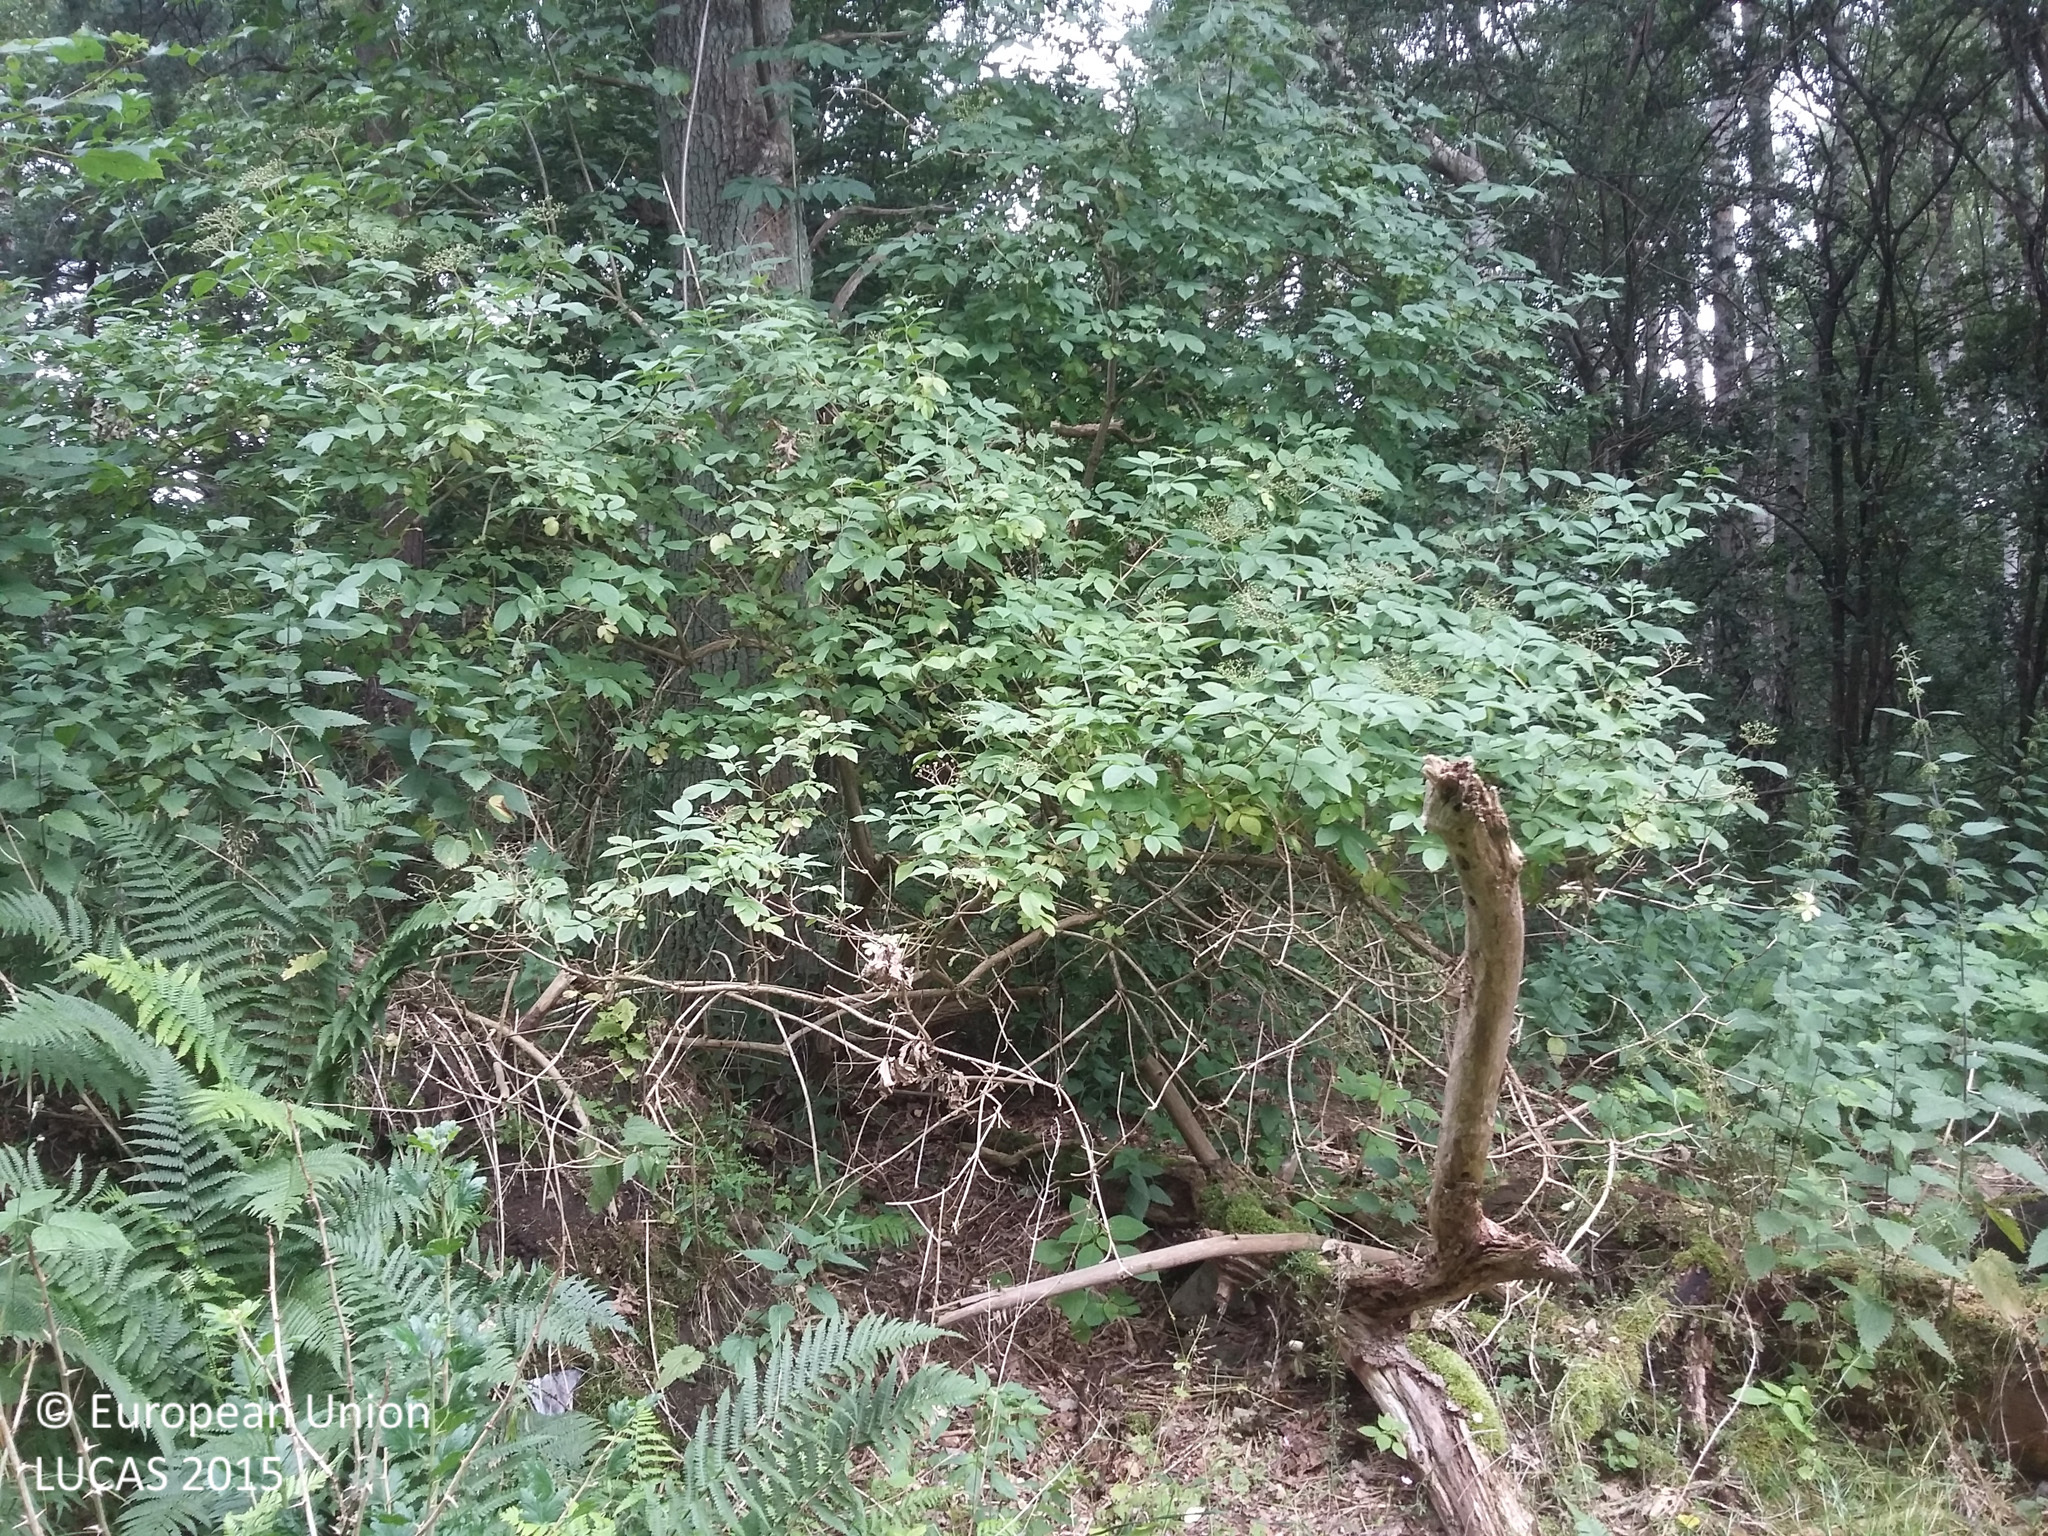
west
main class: Woodland
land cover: Broadleaved woodland
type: thermophilous deciduous forest
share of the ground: 50 - 75 %
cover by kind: herbaceous plants 50 %, broadleaved forest trees 45 %, coniferous forest trees 5 %
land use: Semi-natural and natural areas not in use
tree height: > 5 m
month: July
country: DK
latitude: 55.8031
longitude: 12.5345
